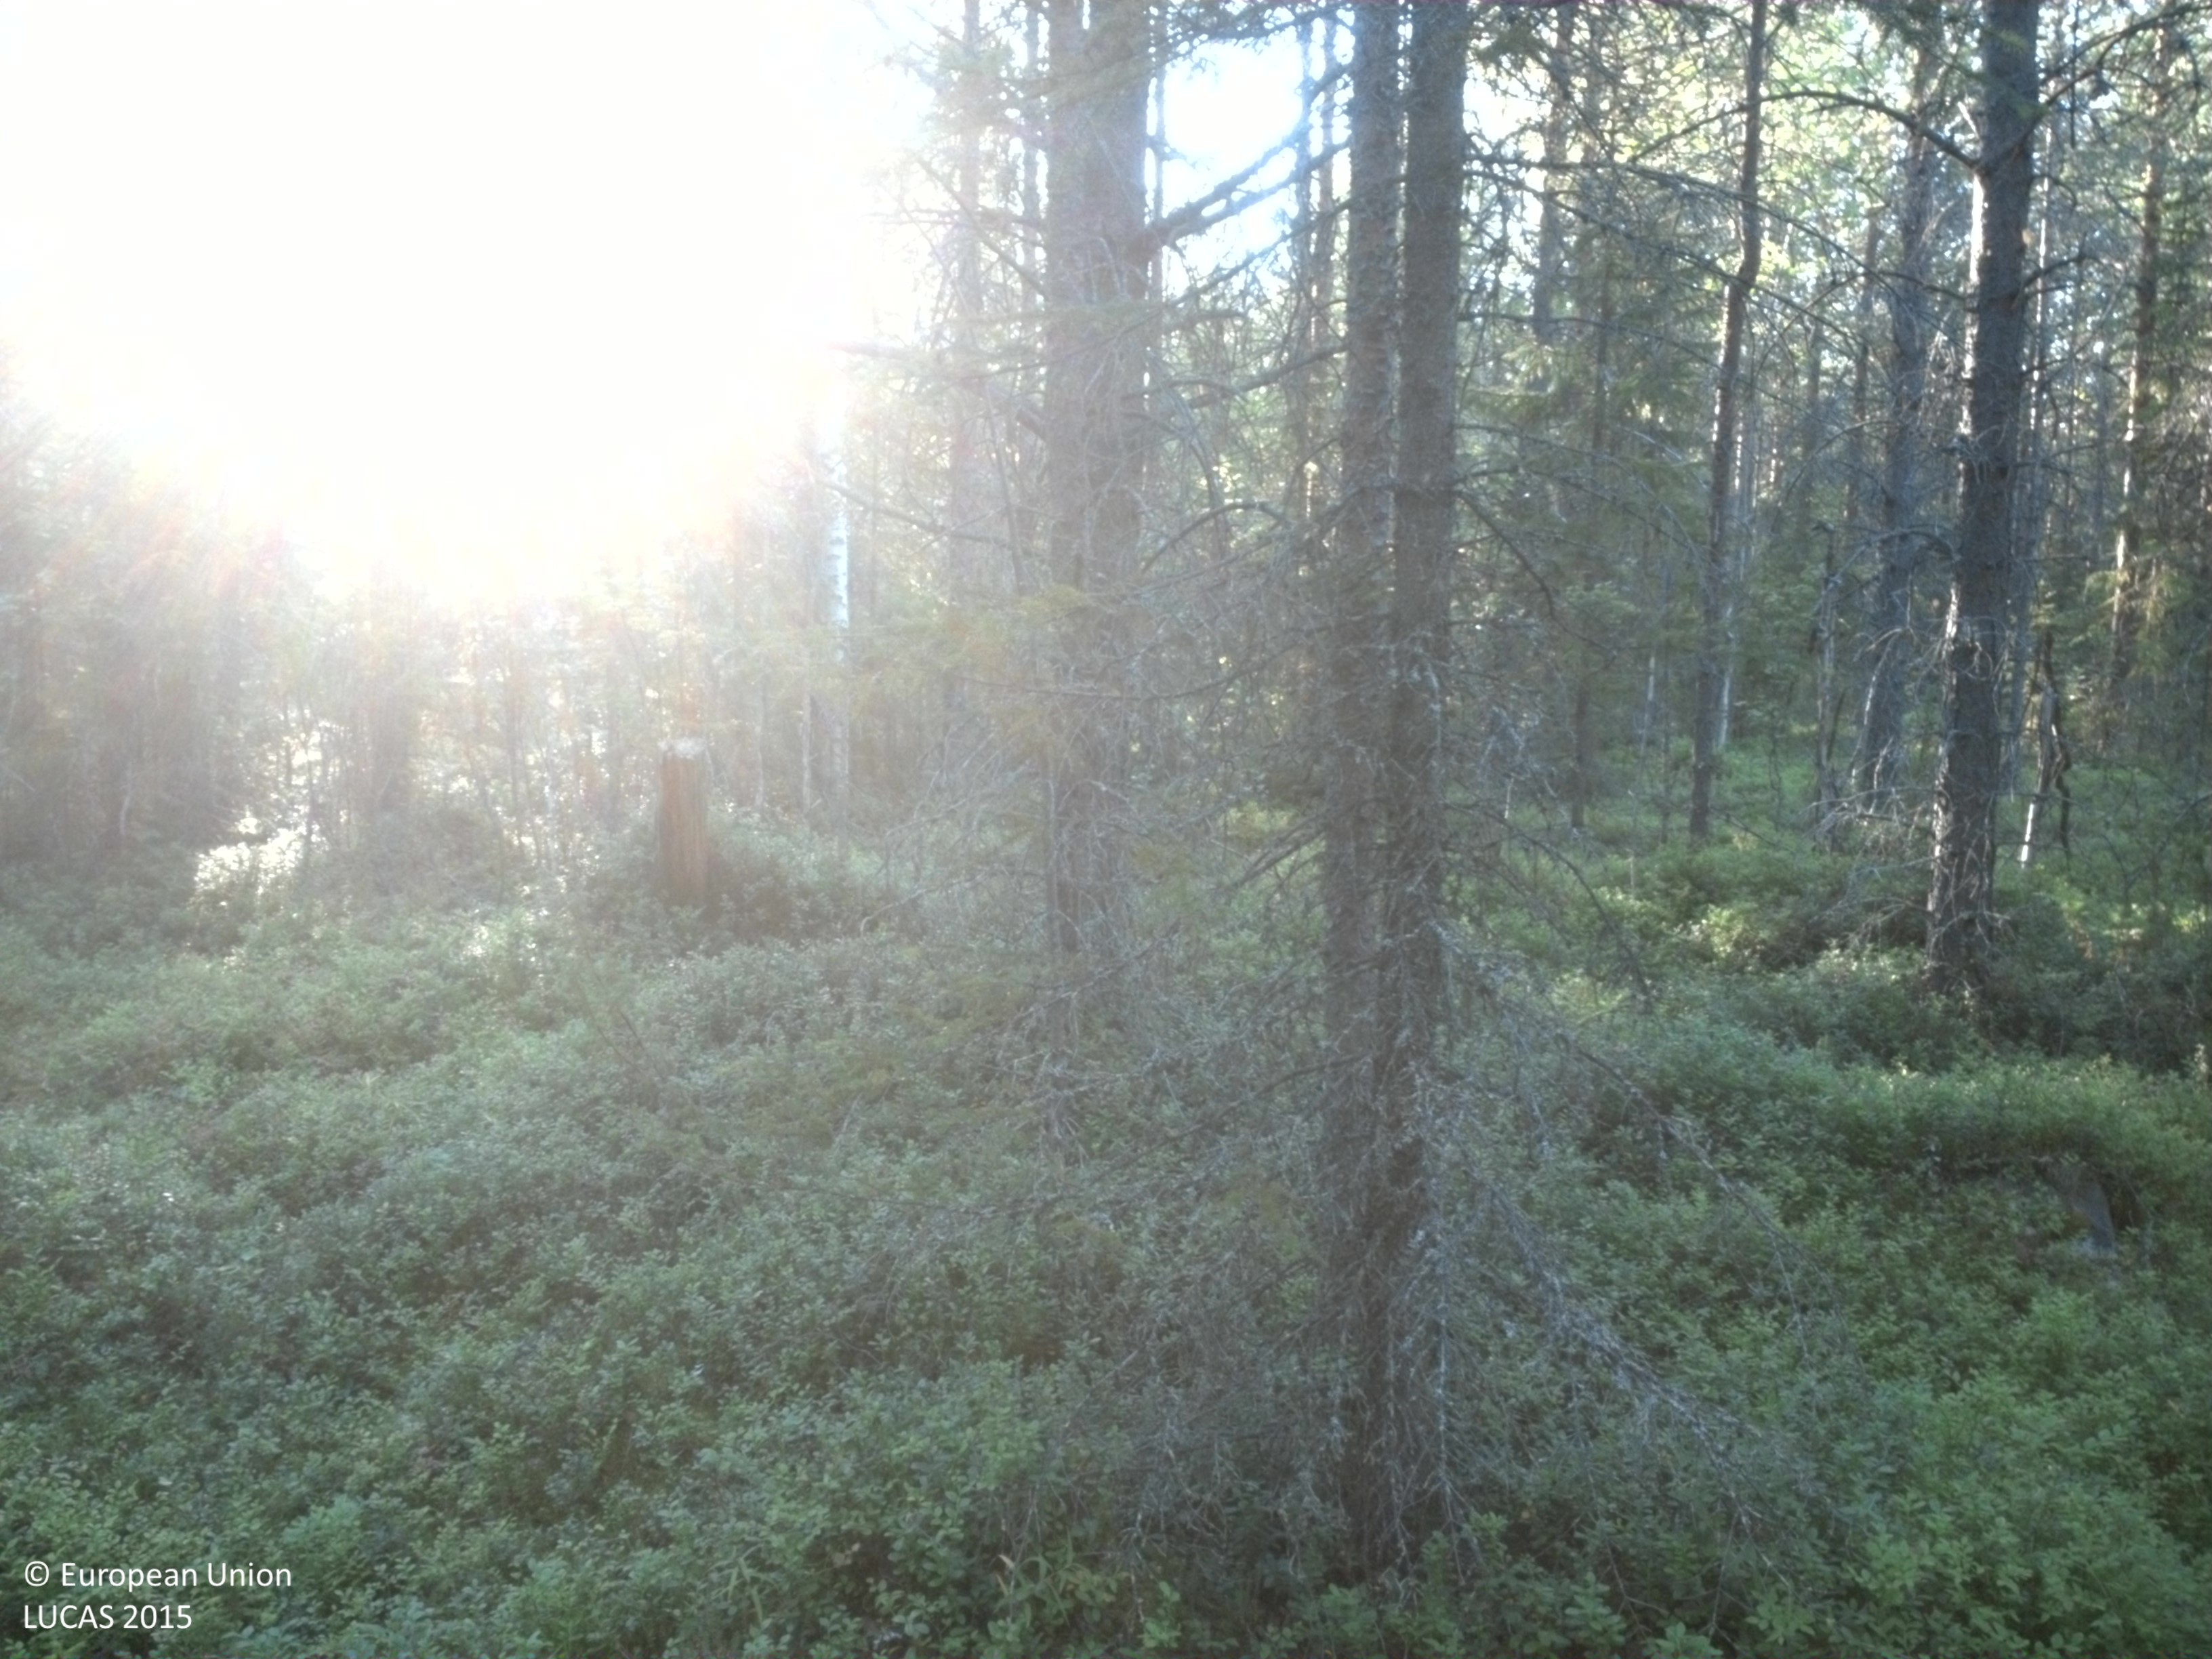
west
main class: Woodland
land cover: Pine dominated mixed woodland
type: boreal forest
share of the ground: 50 - 75 %
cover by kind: coniferous forest trees 45 %, shrubs 35 %, broadleaved forest trees 15 %, lichens and mosses 5 %
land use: Forestry
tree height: > 5 m
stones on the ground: 25 - 50 %
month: August
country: SE
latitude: 64.6500
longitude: 19.0327
